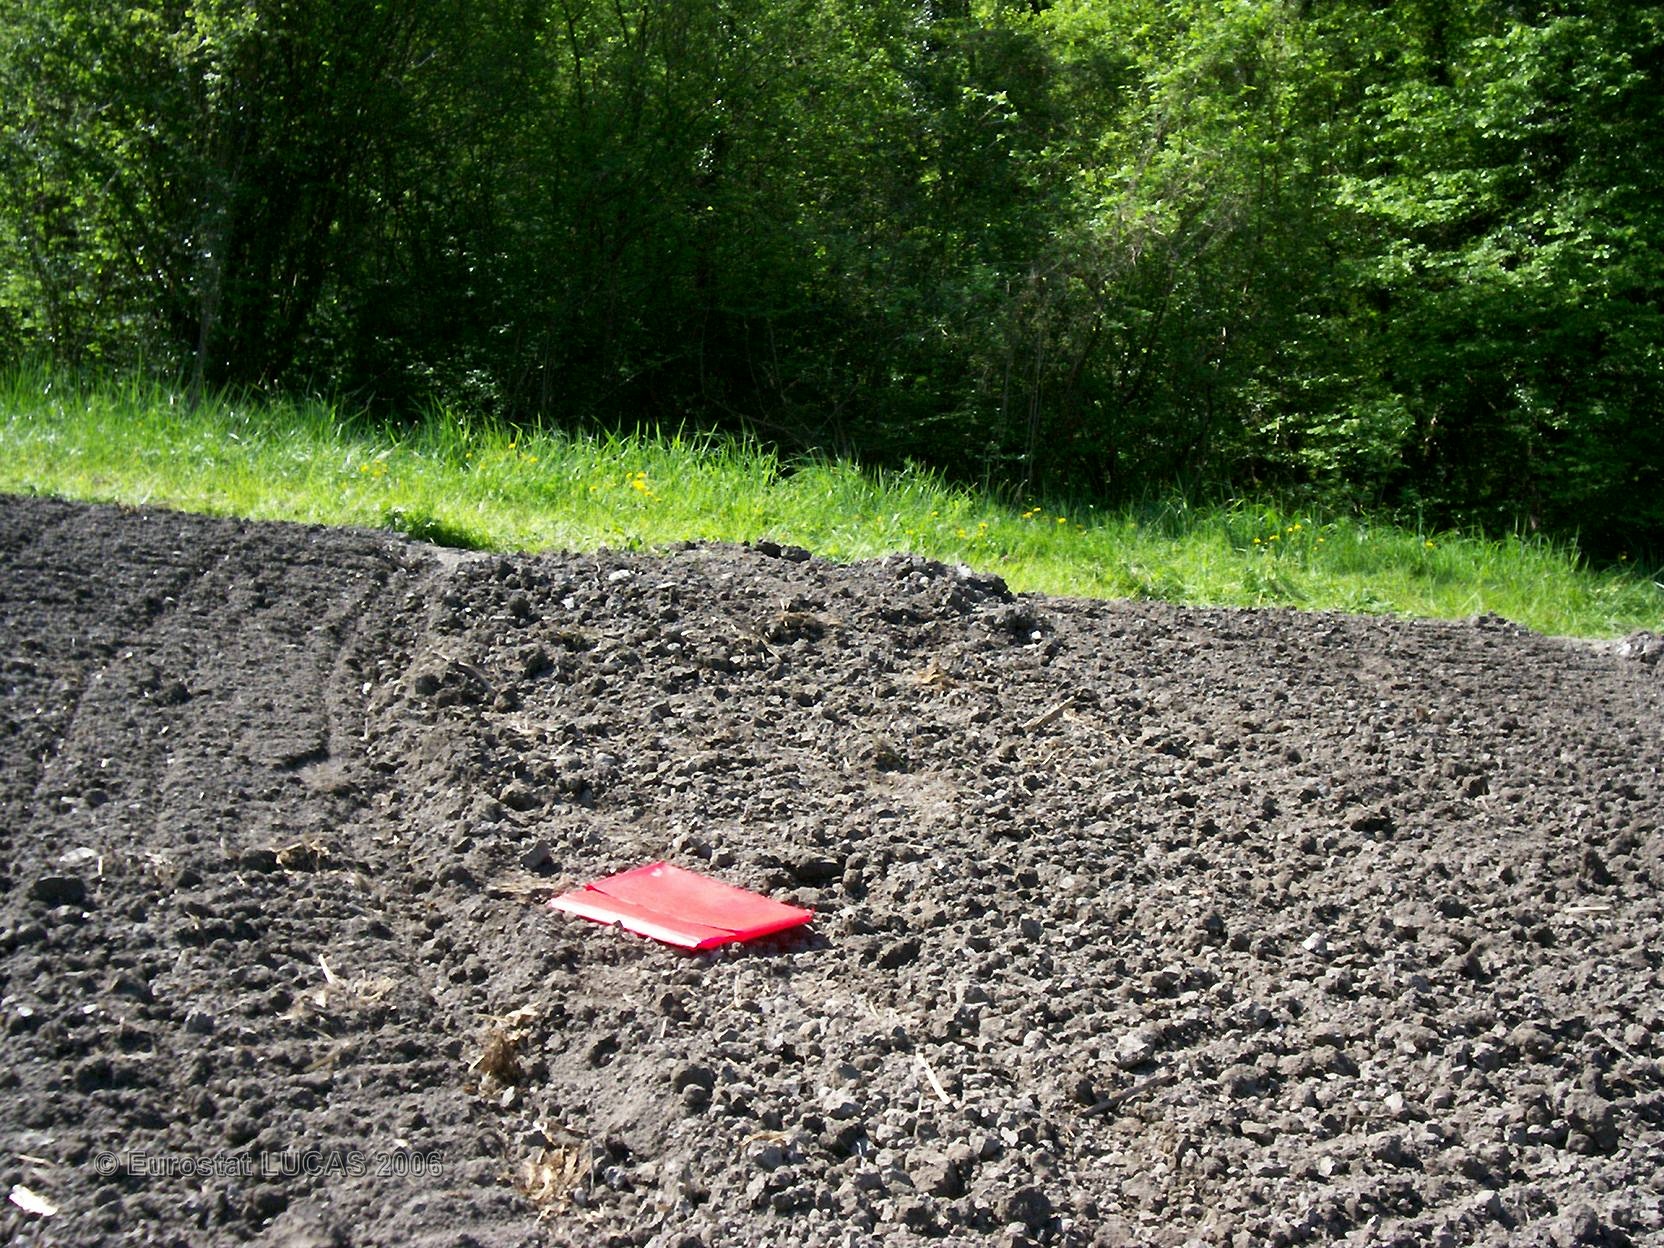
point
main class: Cropland
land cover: Maize
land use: Agriculture (excluding fallow land and kitchen gardens)
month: June
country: FR
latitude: 45.5425
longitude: 6.1496
